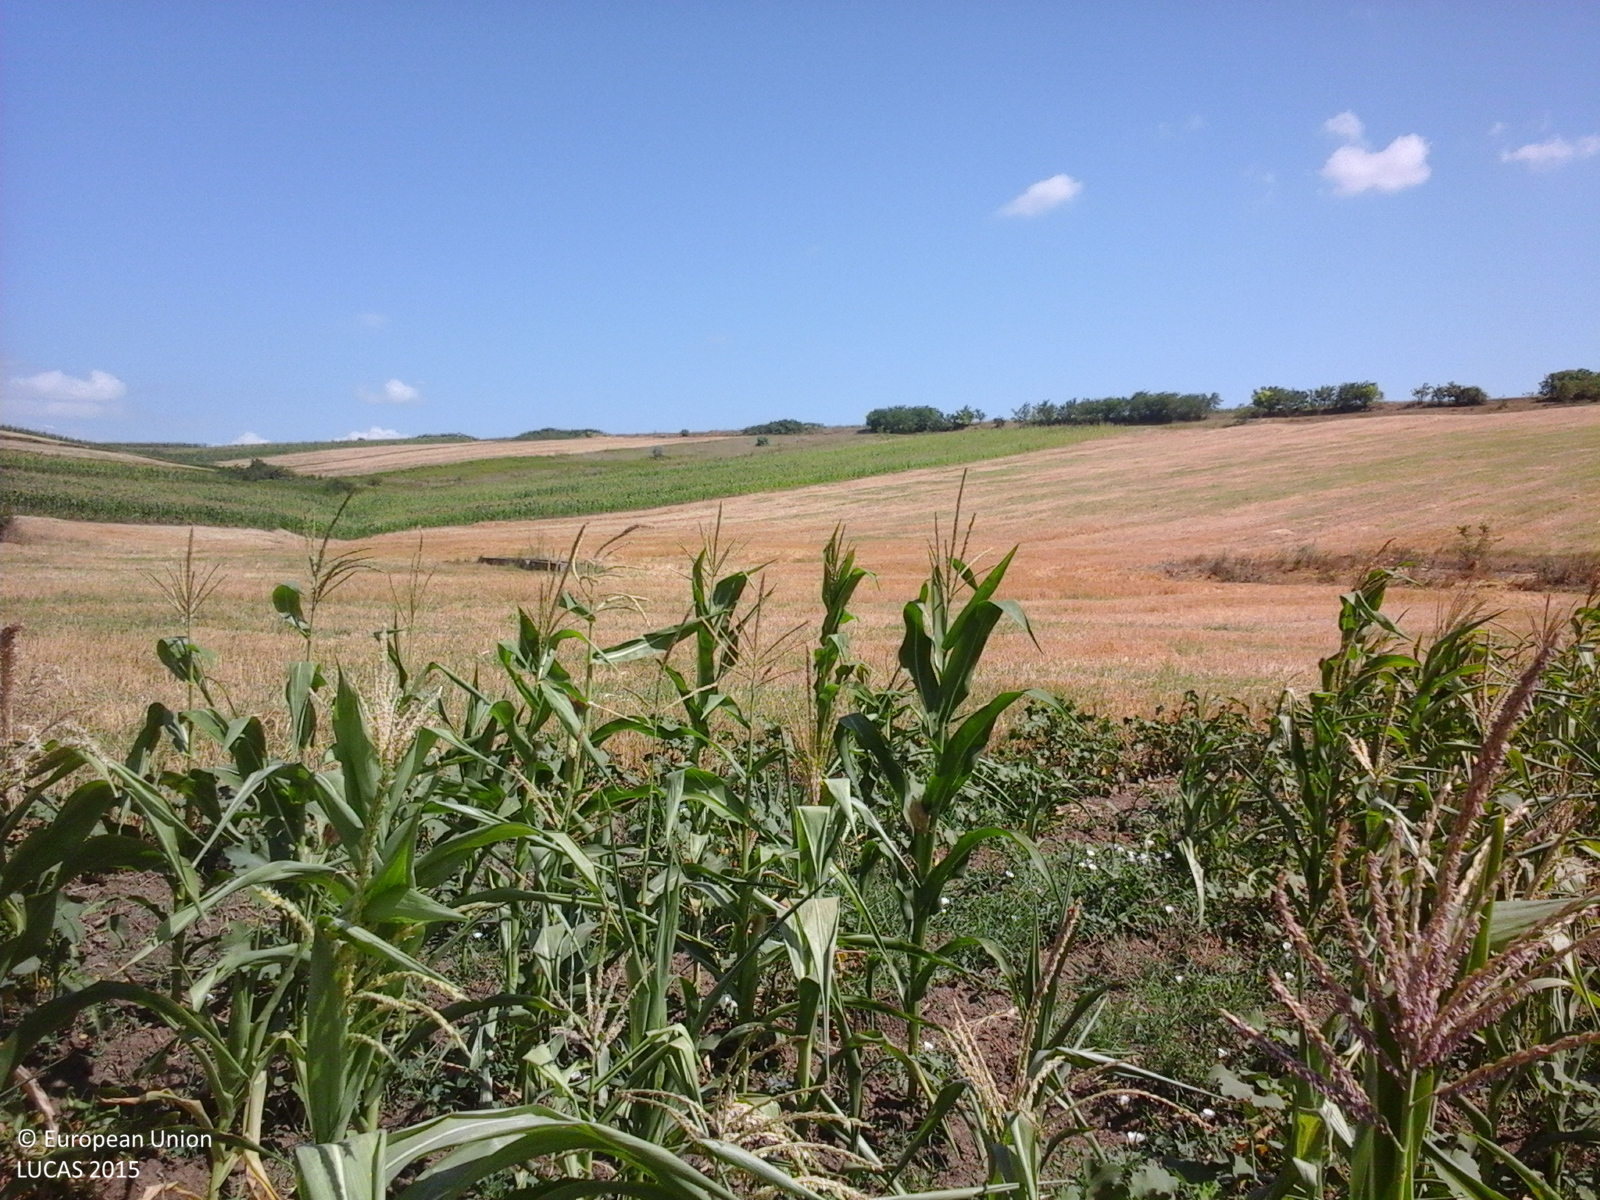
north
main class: Cropland
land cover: Maize
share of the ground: > 75 %
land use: Agriculture (excluding fallow land and kitchen gardens)
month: July
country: RO
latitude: 46.3529
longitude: 27.9129
